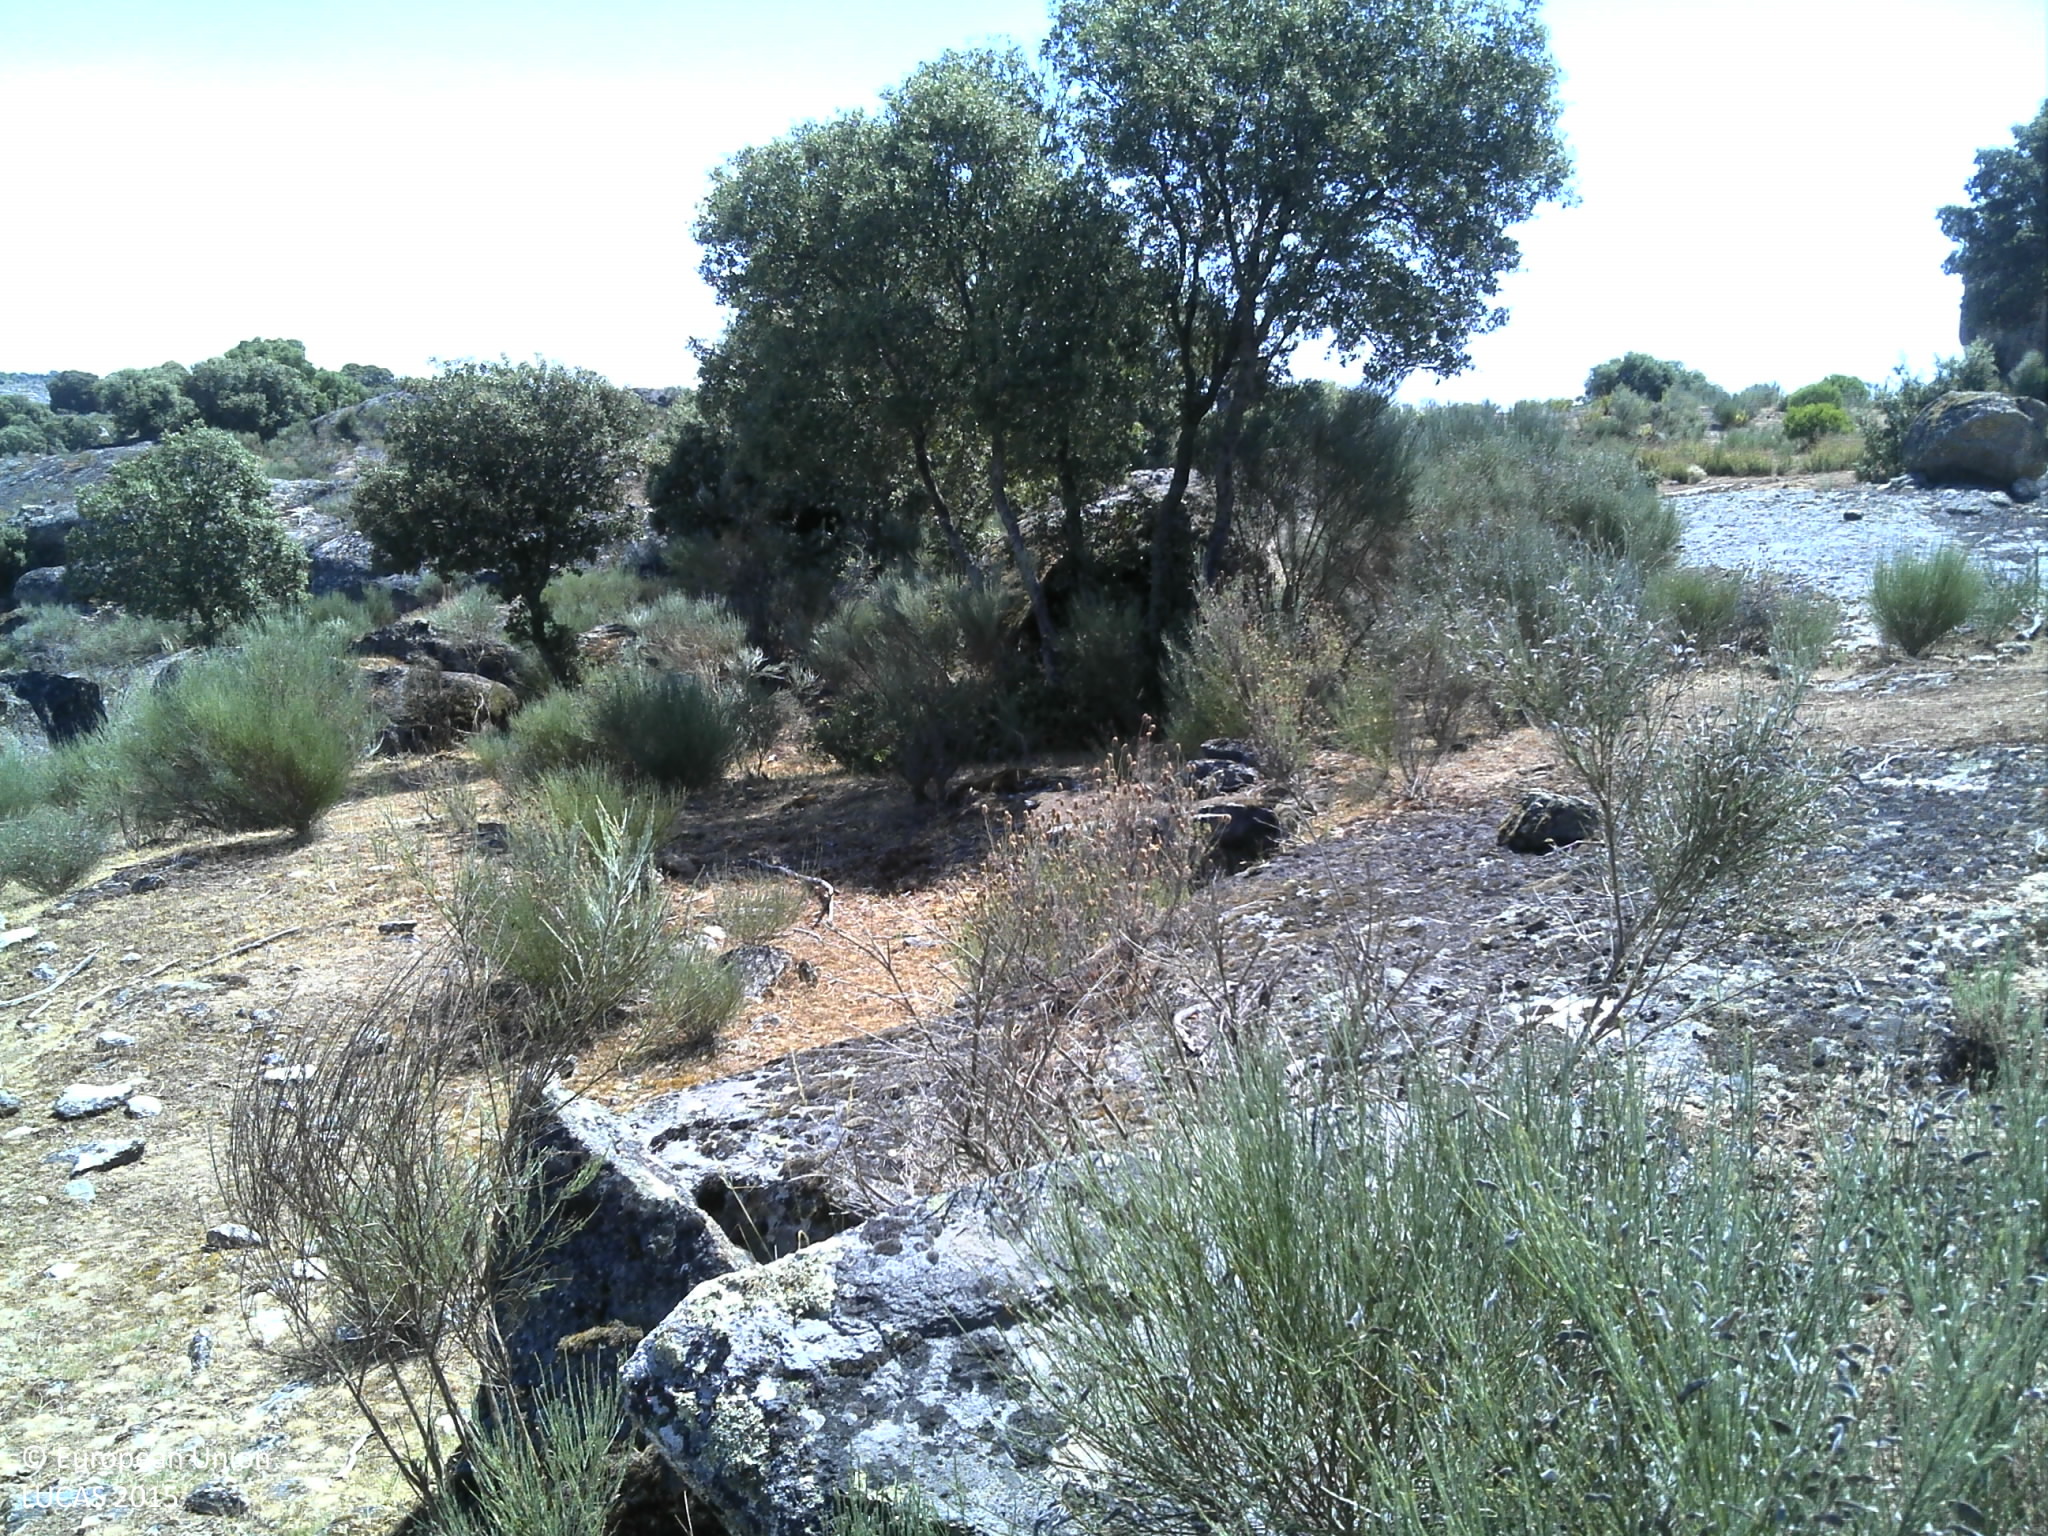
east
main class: Grassland
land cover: Grassland with sparse tree/shrub cover
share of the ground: 25 - 50 %
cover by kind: consolidated bare surface 45 %, herbaceous plants 40 %, shrubs 10 %, broadleaved forest trees 5 %
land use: Agriculture (excluding fallow land and kitchen gardens)
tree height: > 5 m
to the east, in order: Grassland with sparse tree/shrub cover; Rocks and stones; Grassland with sparse tree/shrub cover; Fences; Tracks; Grassland with sparse tree/shrub cover; Rocks and stones; Grassland with sparse tree/shrub cover; Rocks and stones; Dry stone walls; Rocks and stones; Grassland with sparse tree/shrub cover
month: June
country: PT
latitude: 40.7692
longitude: -6.9609
